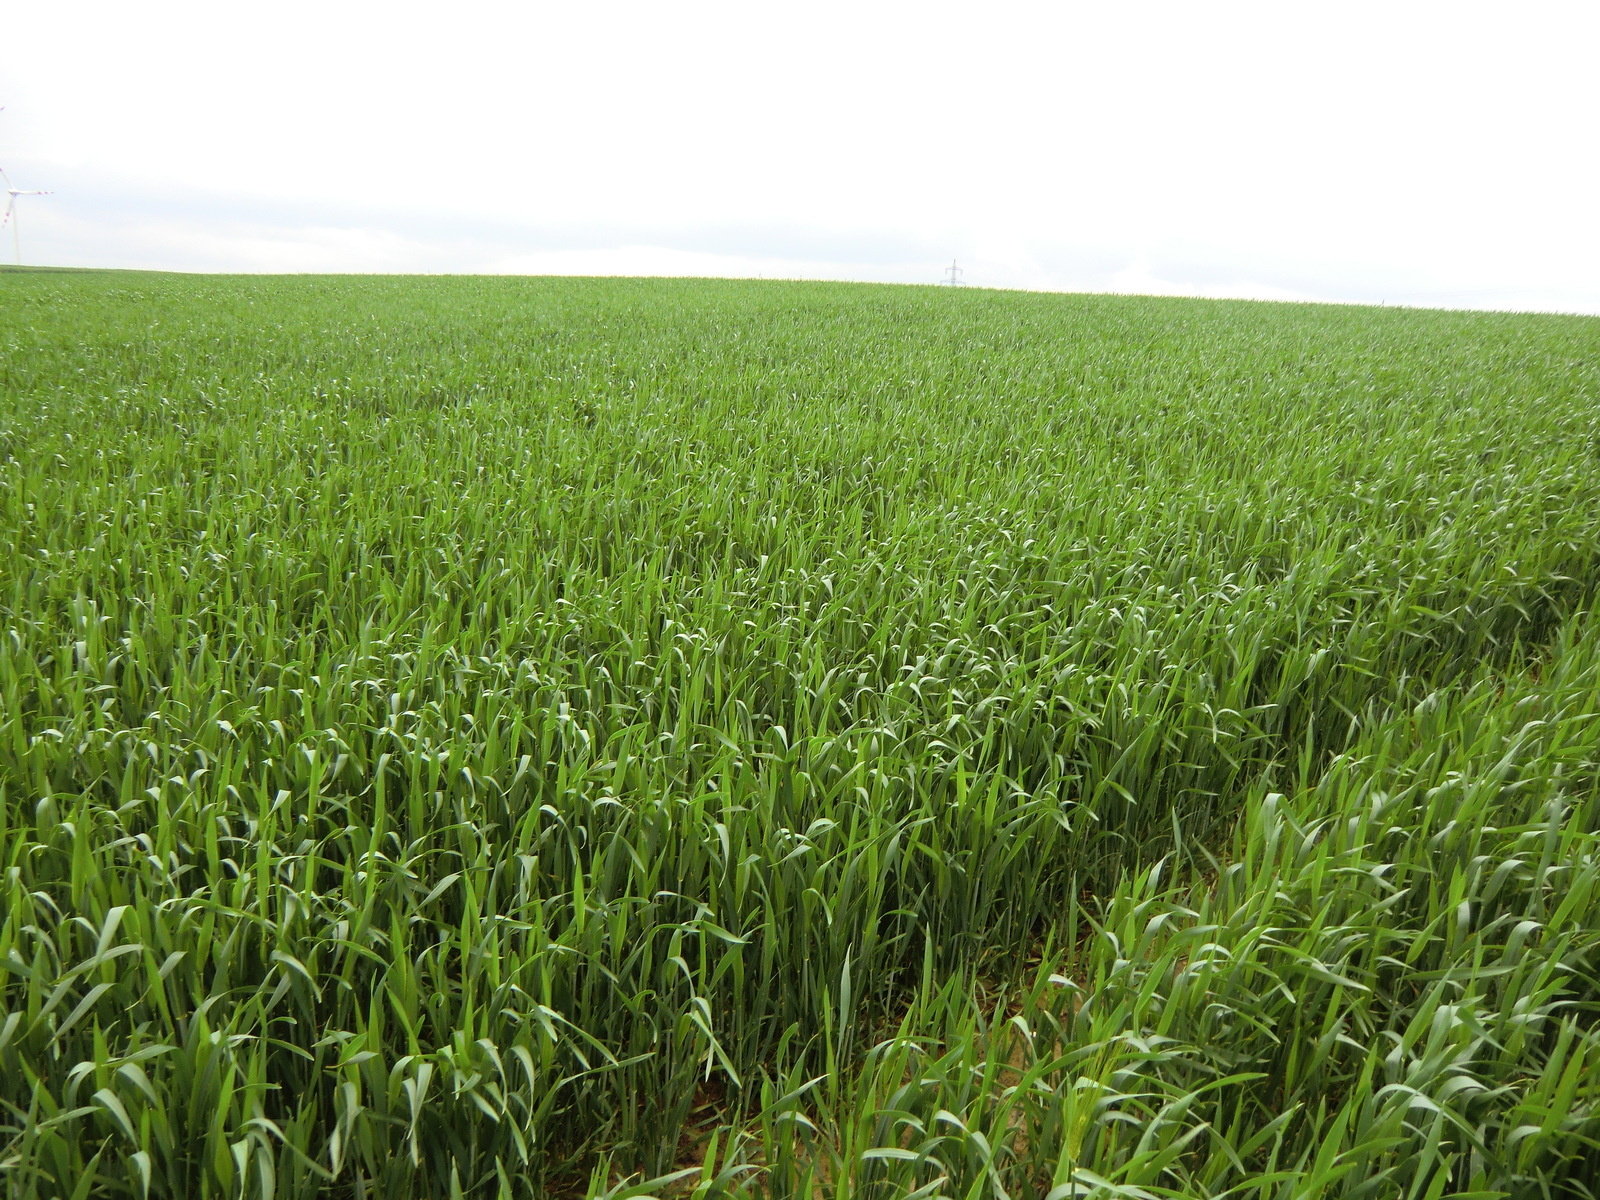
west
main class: Cropland
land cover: Common wheat
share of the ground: > 75 %
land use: Agriculture (excluding fallow land and kitchen gardens)
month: May
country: AT
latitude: 48.1790
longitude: 15.4490
